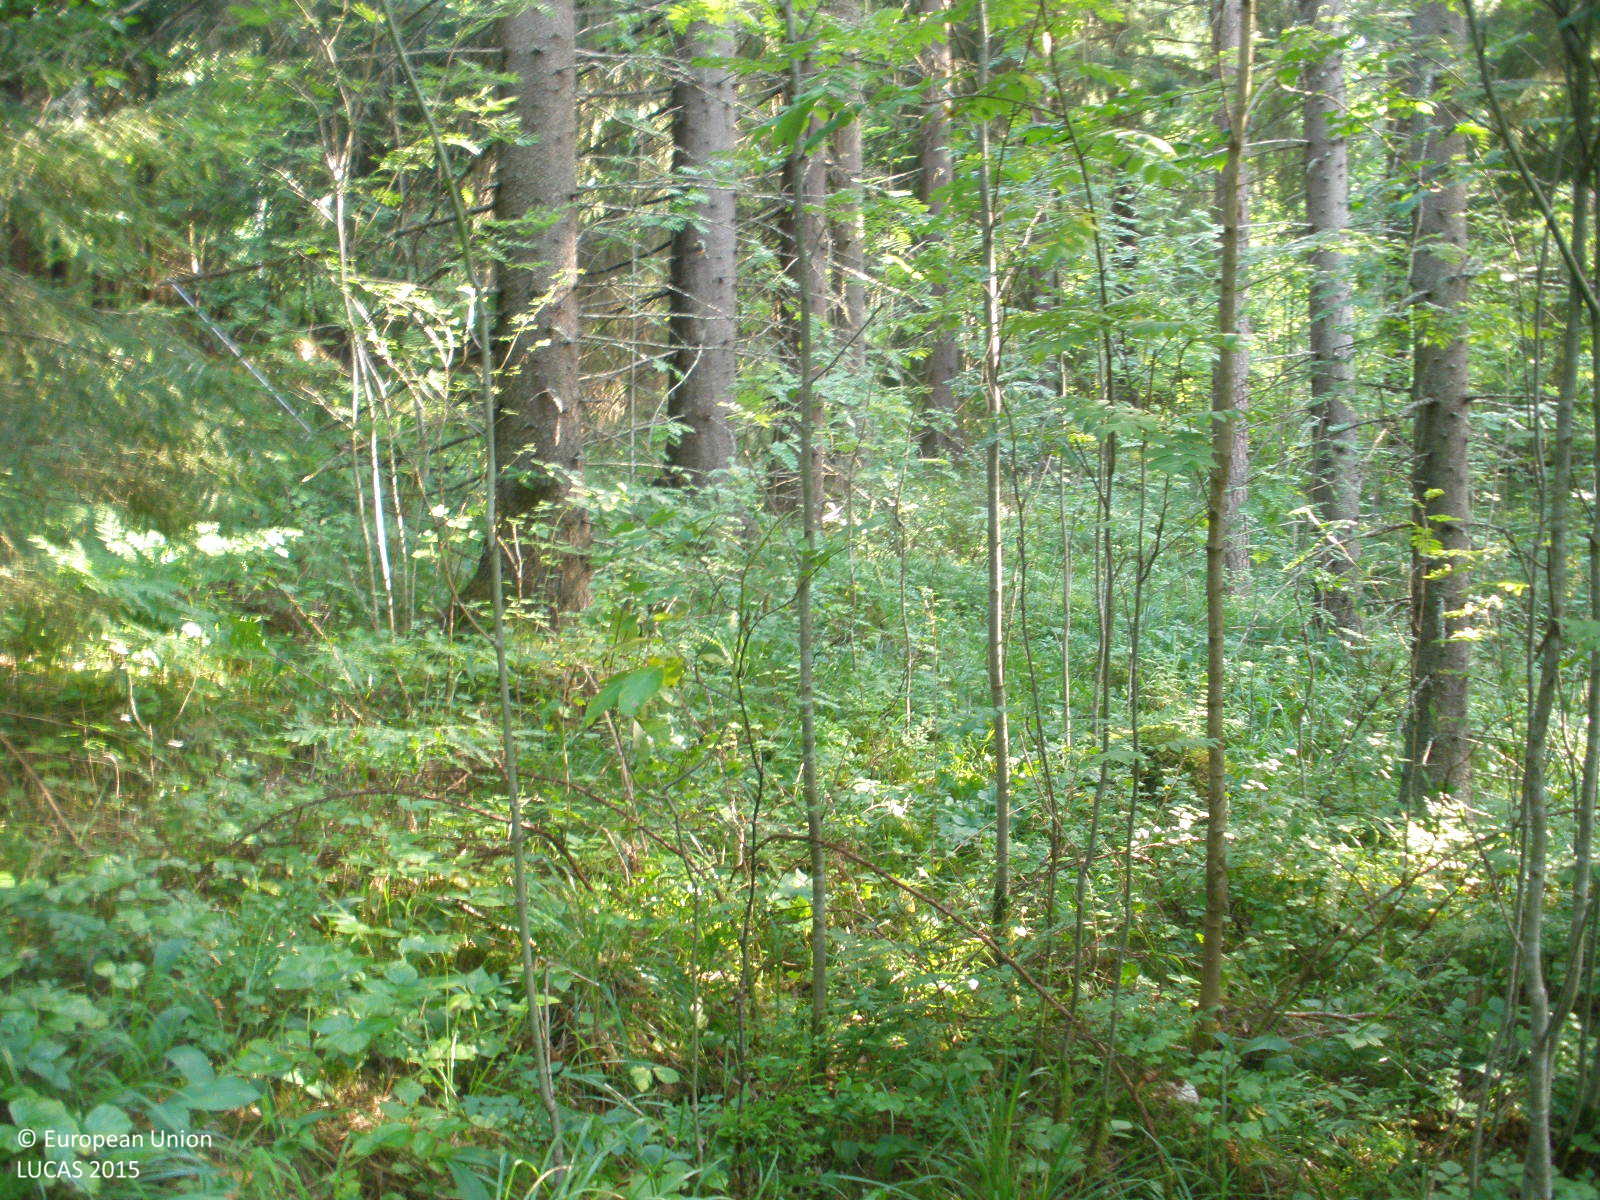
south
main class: Woodland
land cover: Spruce dominated mixed woodland
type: boreal forest
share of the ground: > 75 %
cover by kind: coniferous forest trees 65 %, broadleaved forest trees 25 %, herbaceous plants 10 %
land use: Forestry
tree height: > 5 m
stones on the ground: < 10 %
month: August
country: FI
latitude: 60.9740
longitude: 24.7974
